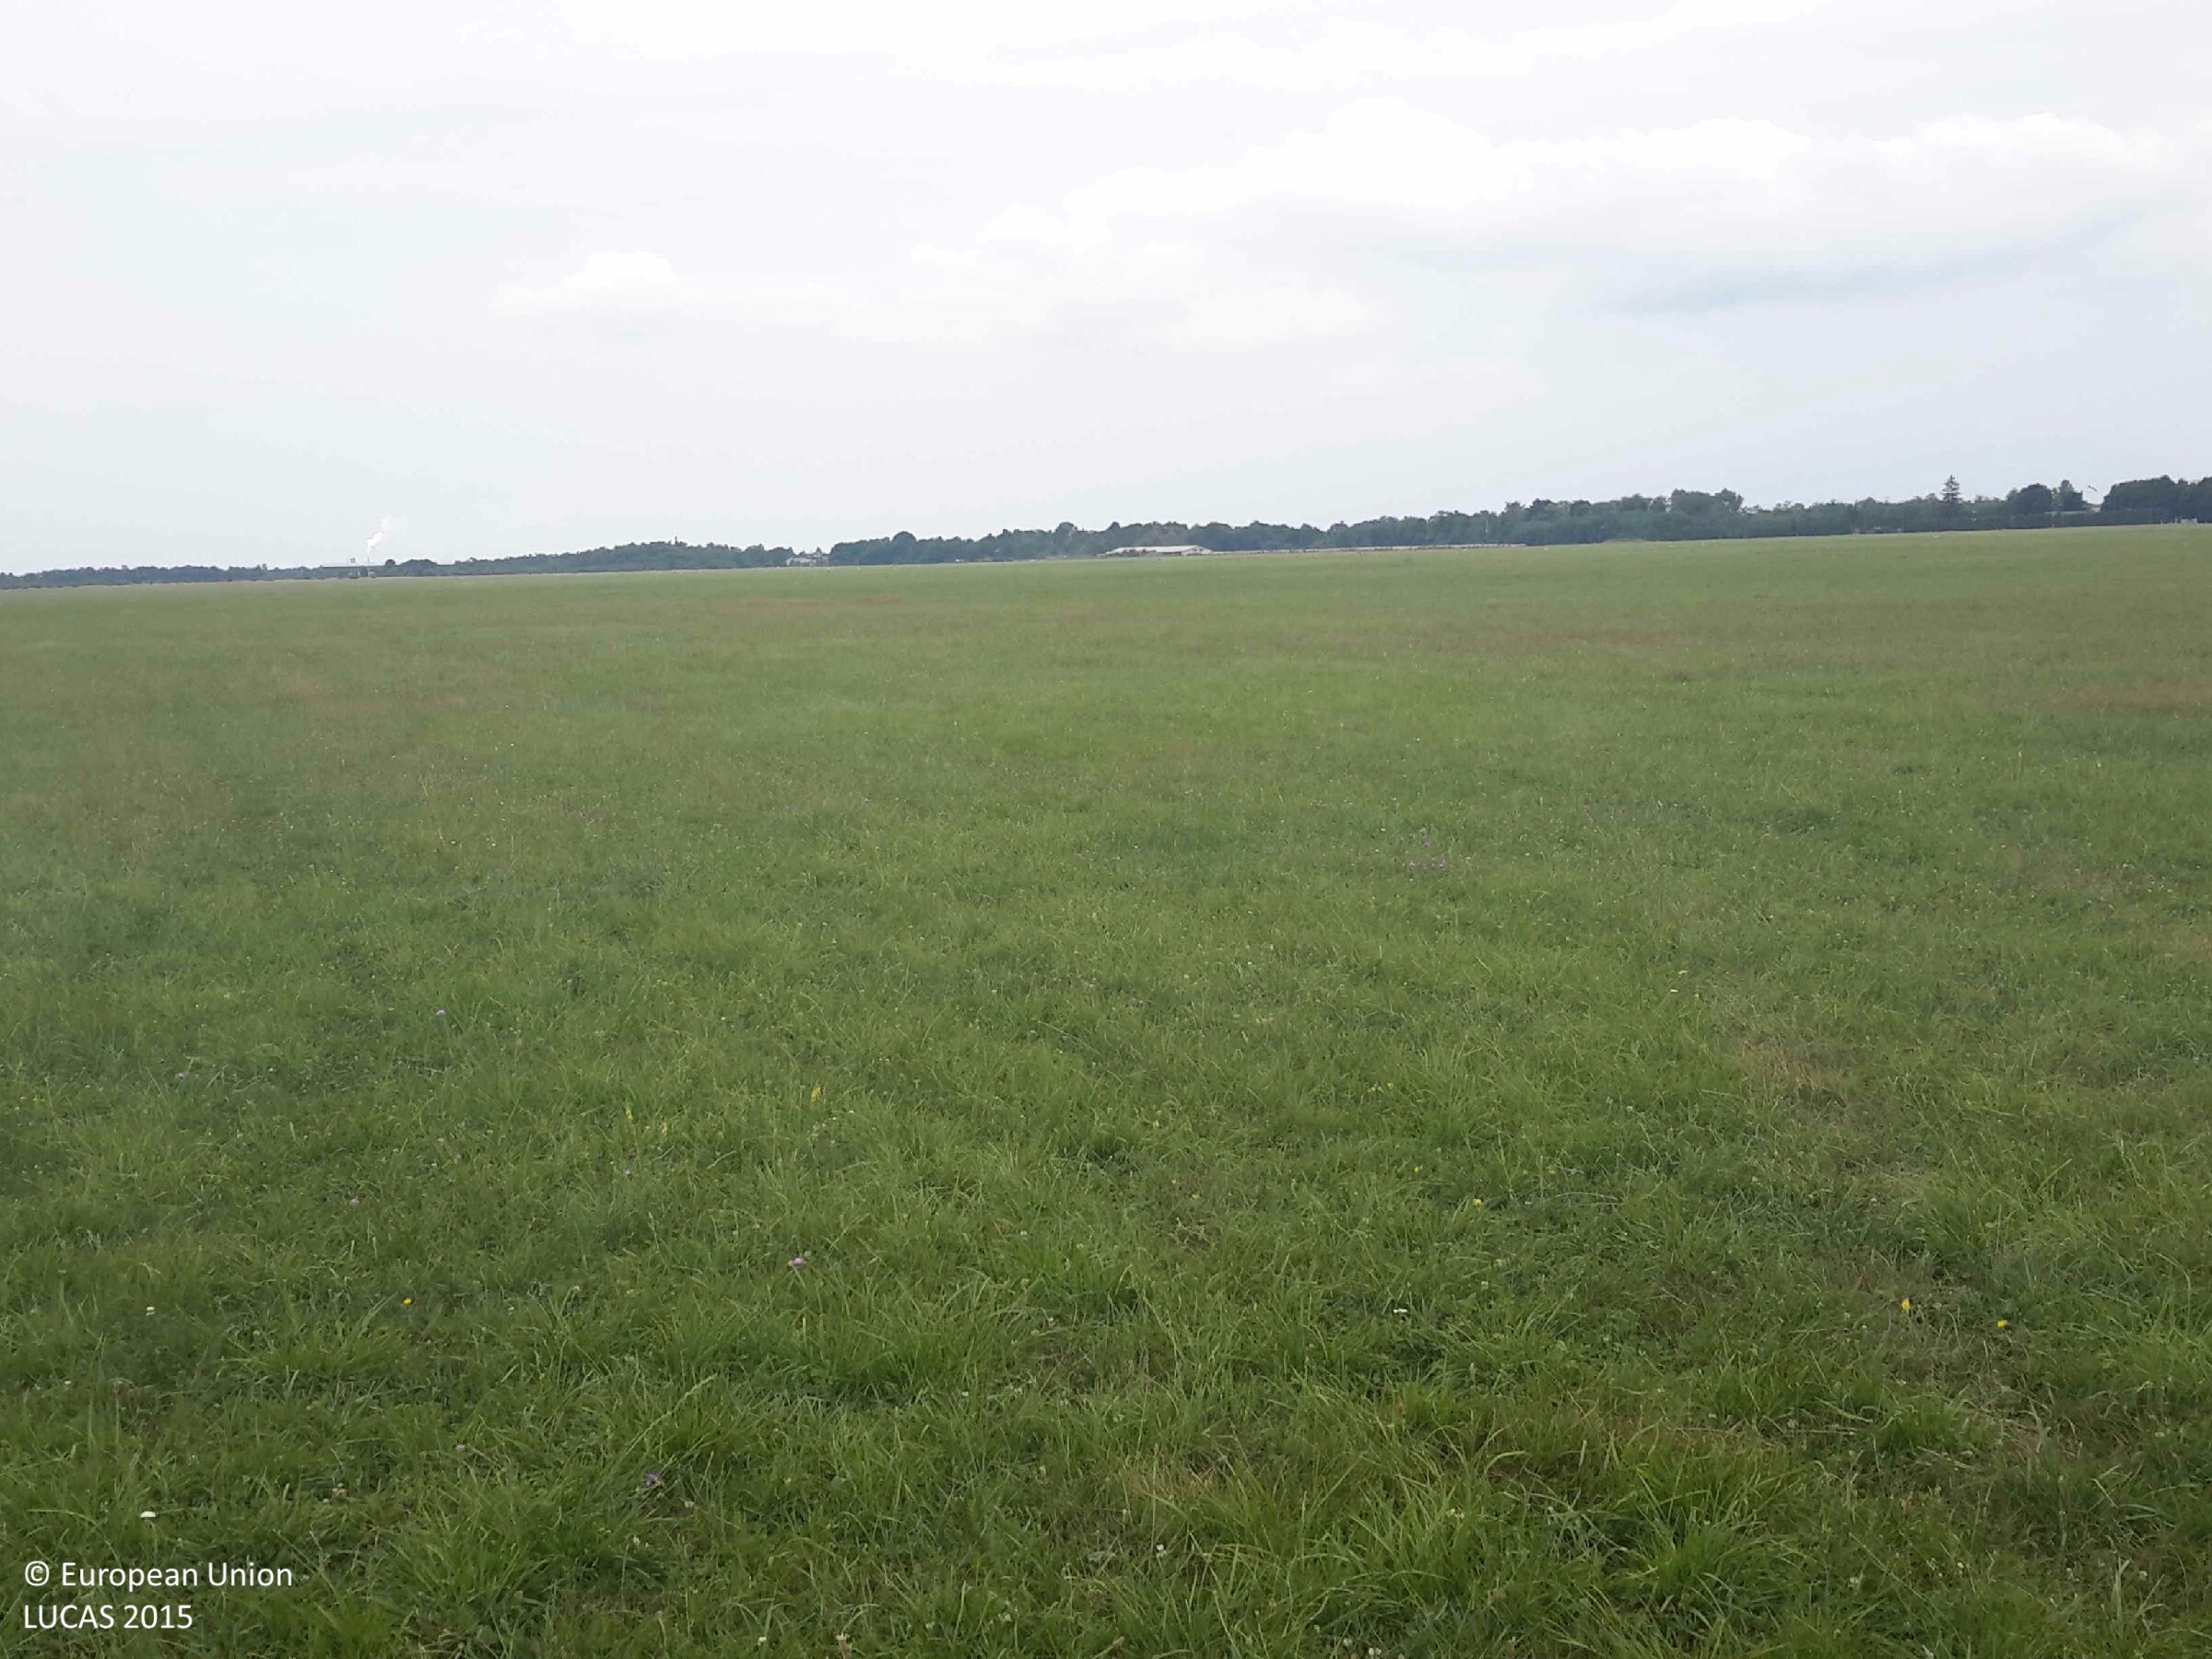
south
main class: Grassland
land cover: Grassland without tree/shrub cover
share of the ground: > 75 %
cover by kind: herbaceous plants 100 %
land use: Agriculture (excluding fallow land and kitchen gardens)
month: July
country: HU
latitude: 47.2837
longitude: 16.6275
